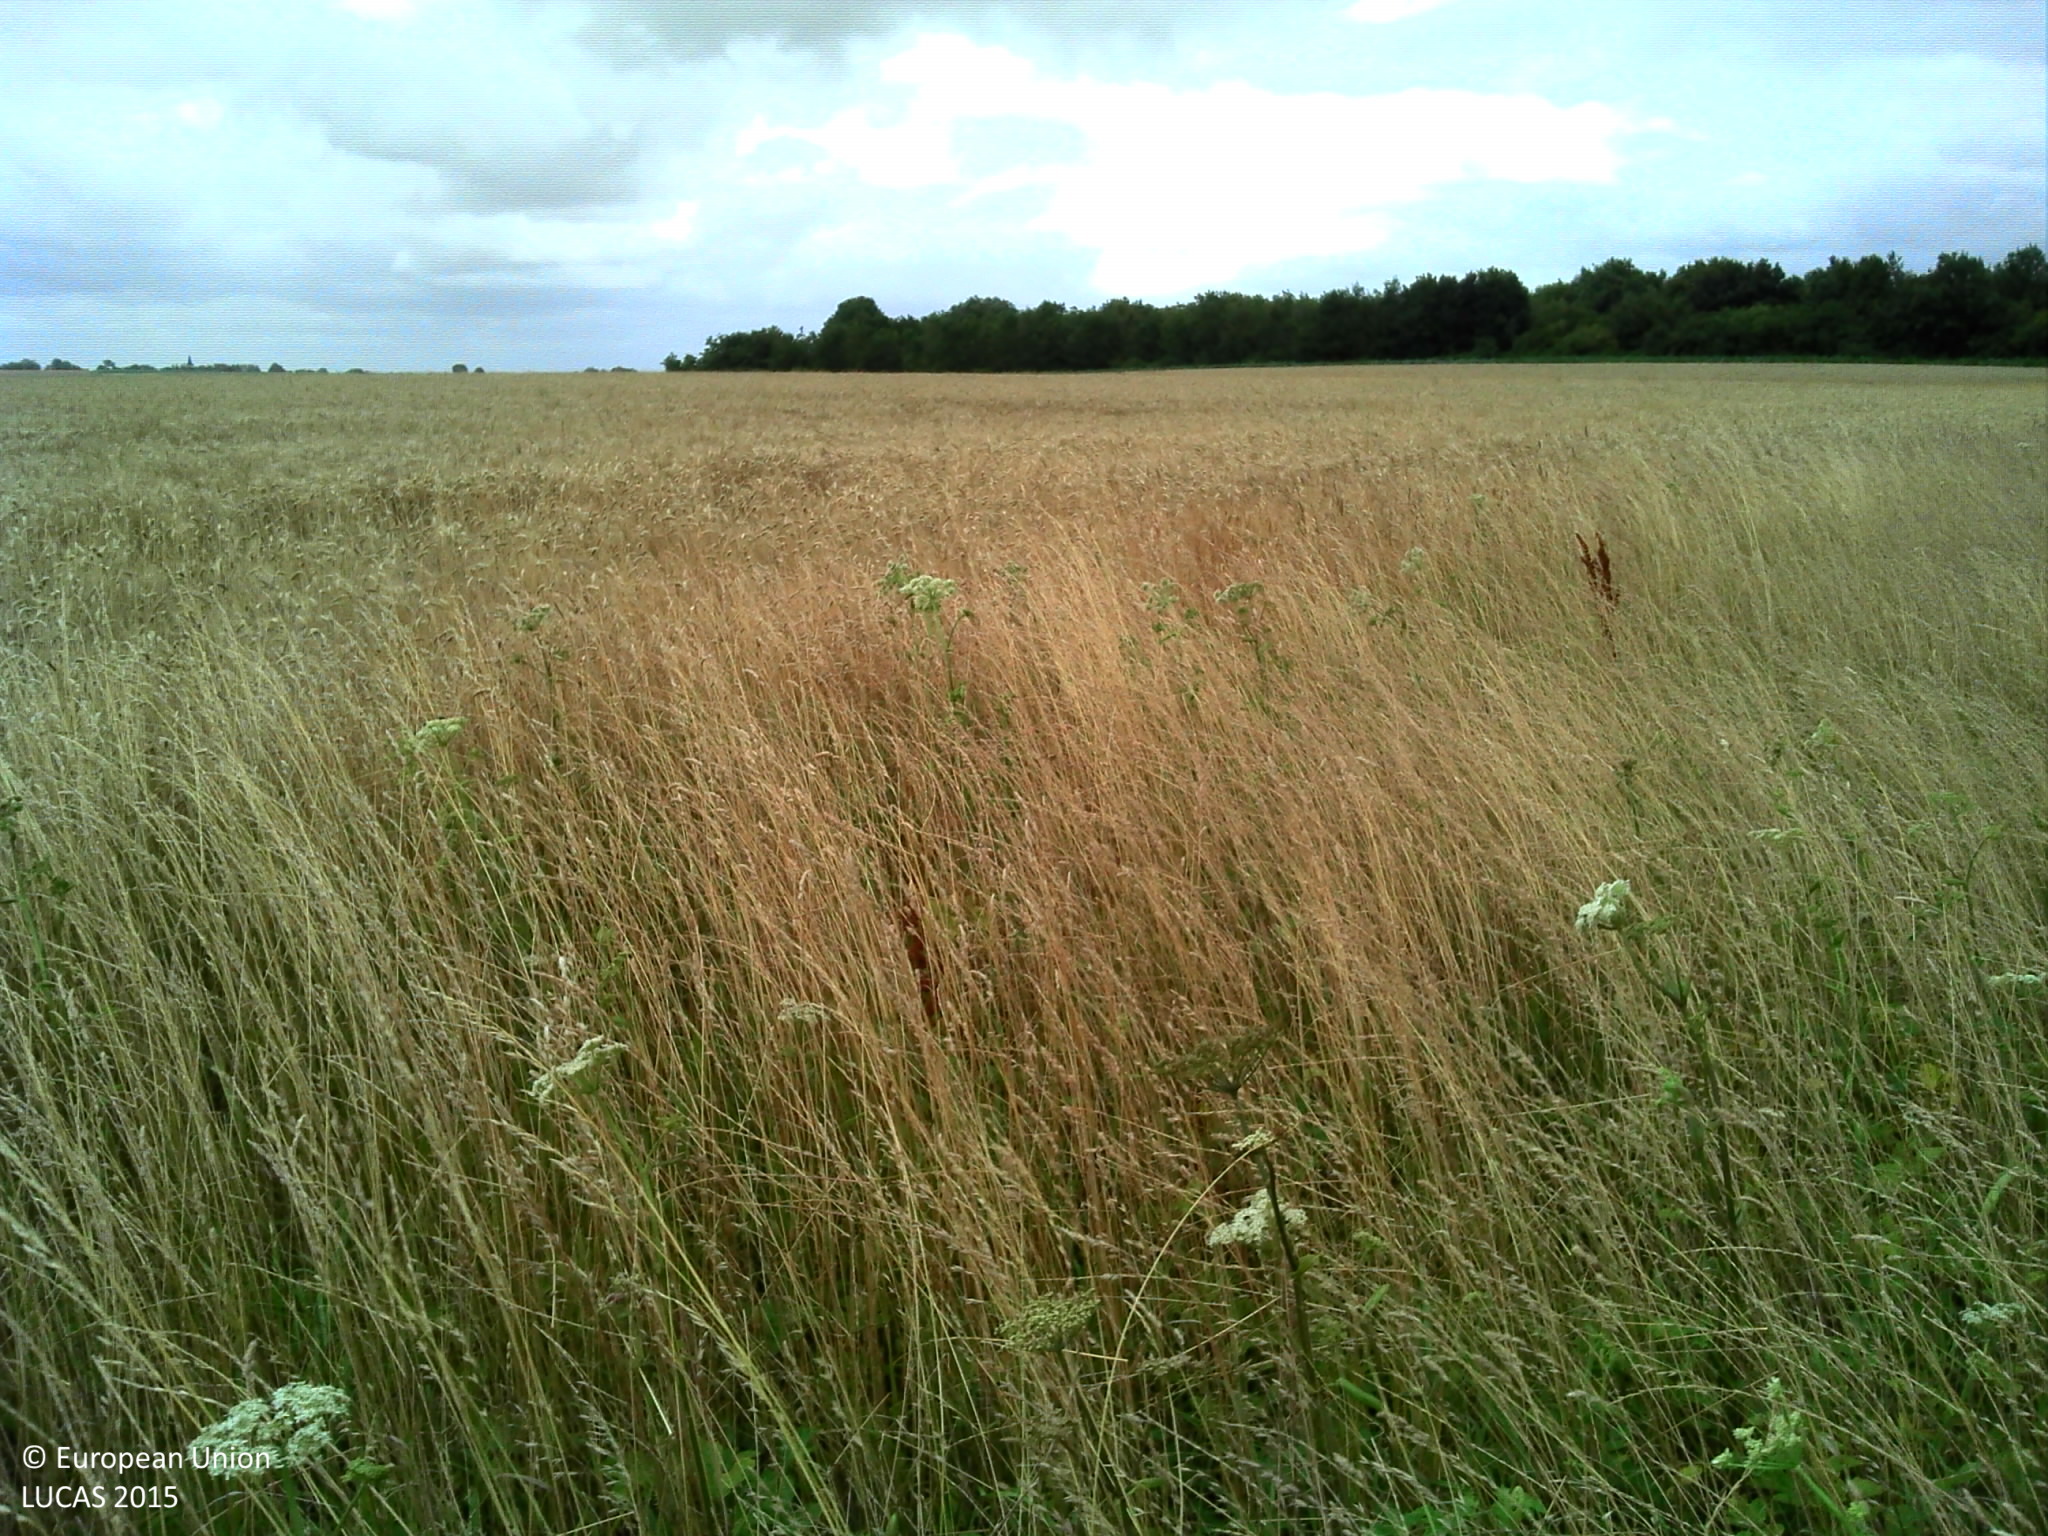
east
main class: Grassland
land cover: Grassland without tree/shrub cover
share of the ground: > 75 %
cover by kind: herbaceous plants 60 %
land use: Agriculture (excluding fallow land and kitchen gardens)
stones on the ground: 10 - 25 %
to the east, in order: Grassland without tree/shrub cover; Common wheat; Maize; Grass margins
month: July
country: FR
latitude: 50.7385
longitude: 2.0636
